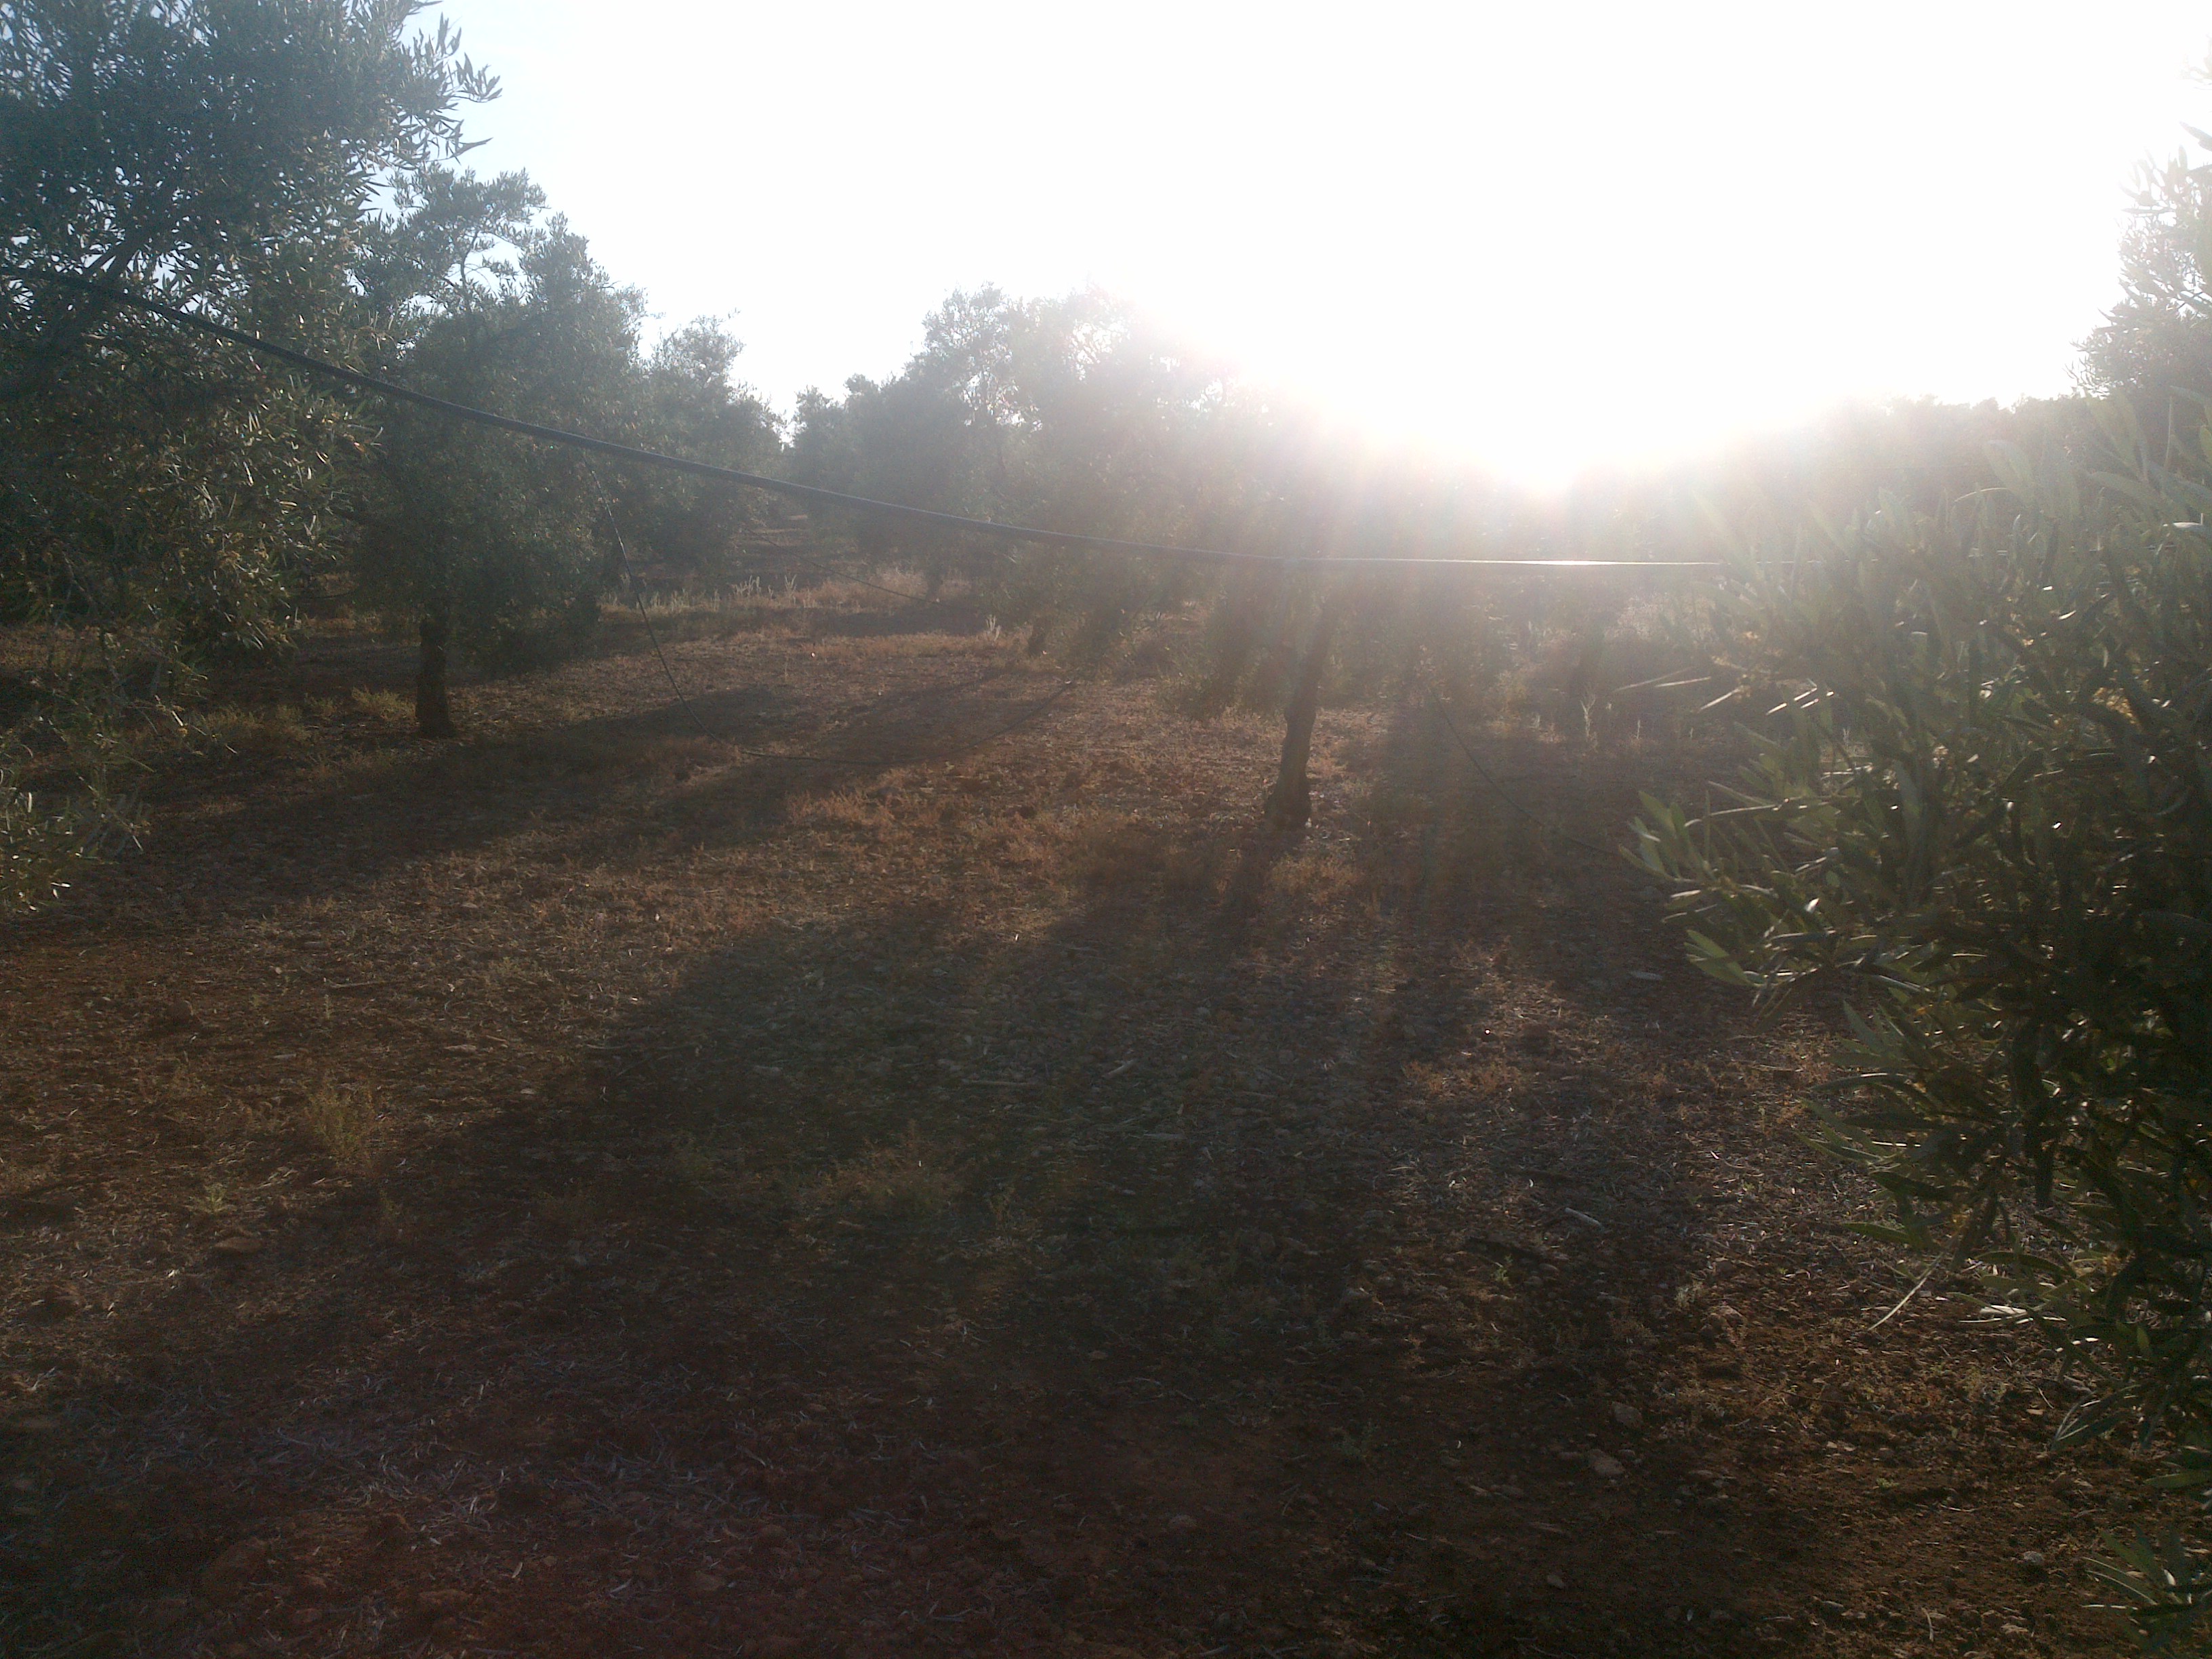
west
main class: Cropland
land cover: Olive groves
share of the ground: 50 - 75 %
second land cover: Other bare soil
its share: > 75 %
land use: Agriculture (excluding fallow land and kitchen gardens)
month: May
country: ES
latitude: 37.3508
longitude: -4.8285
